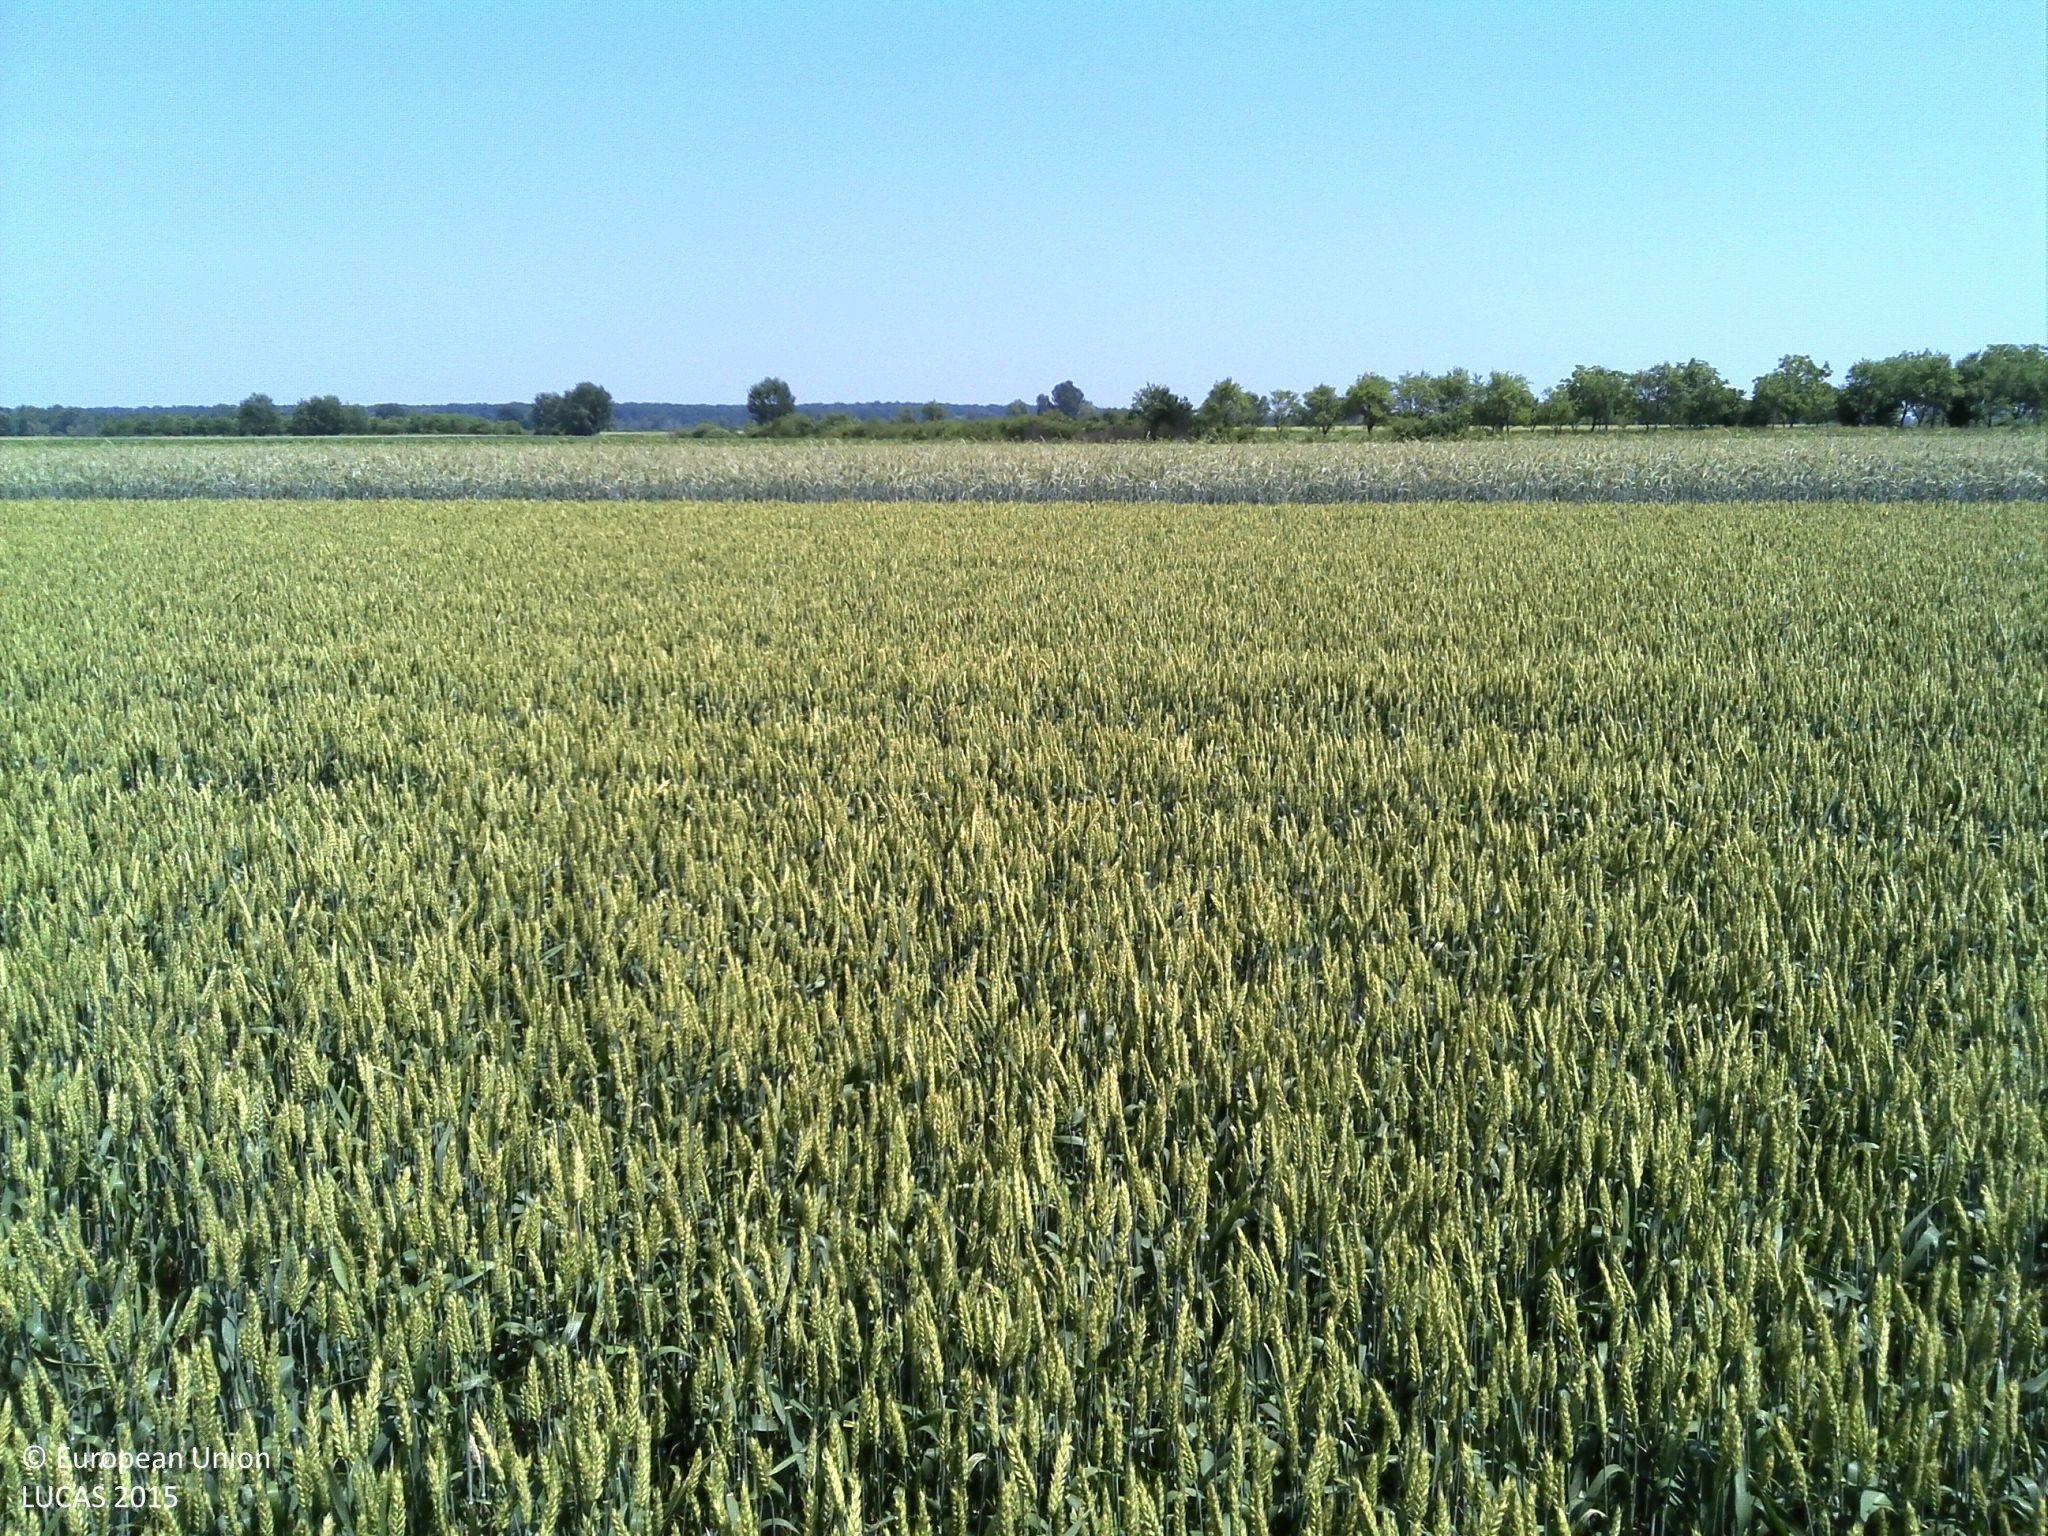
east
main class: Cropland
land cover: Common wheat
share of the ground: > 75 %
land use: Agriculture (excluding fallow land and kitchen gardens)
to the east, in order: Common wheat; Soya; Common wheat; Soya; Tracks; Shrubland without tree cover; Ditches and canals
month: June
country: HR
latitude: 44.9567
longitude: 18.9944
